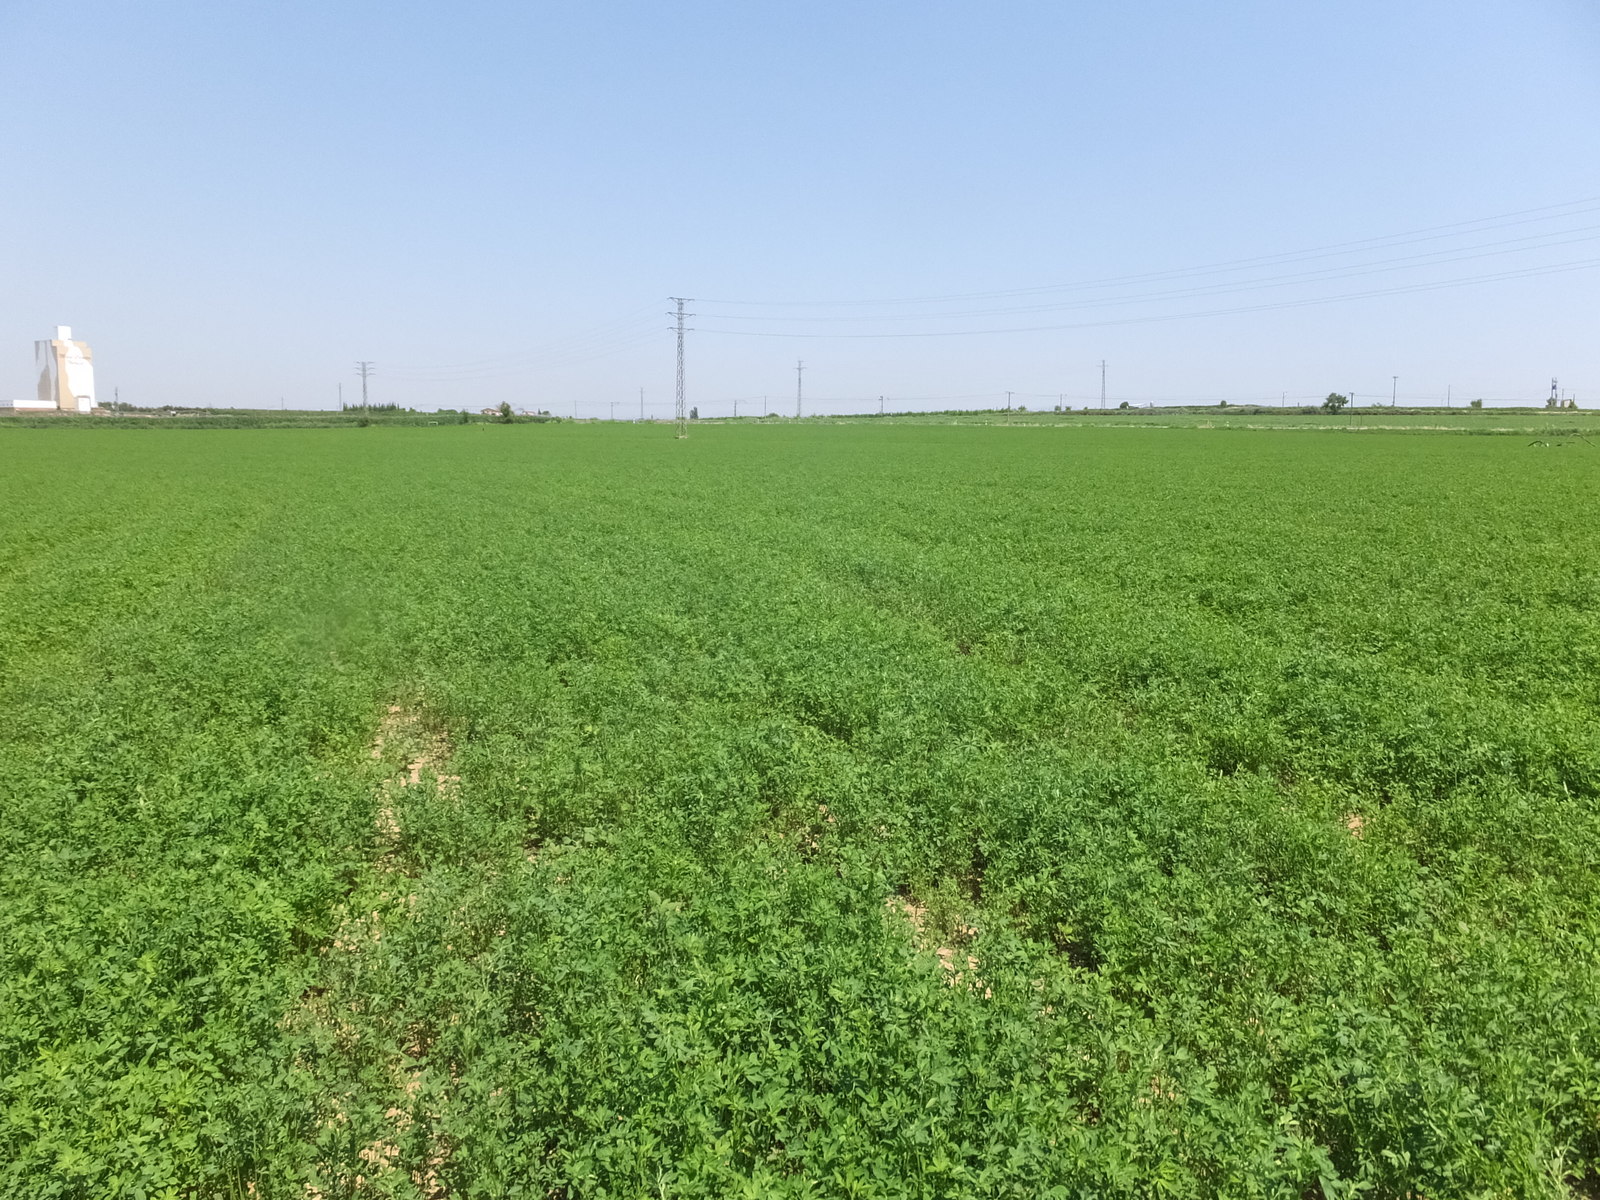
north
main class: Cropland
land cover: Lucerne
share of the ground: > 75 %
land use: Agriculture (excluding fallow land and kitchen gardens)
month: June
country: ES
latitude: 41.7607
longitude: 0.3993
